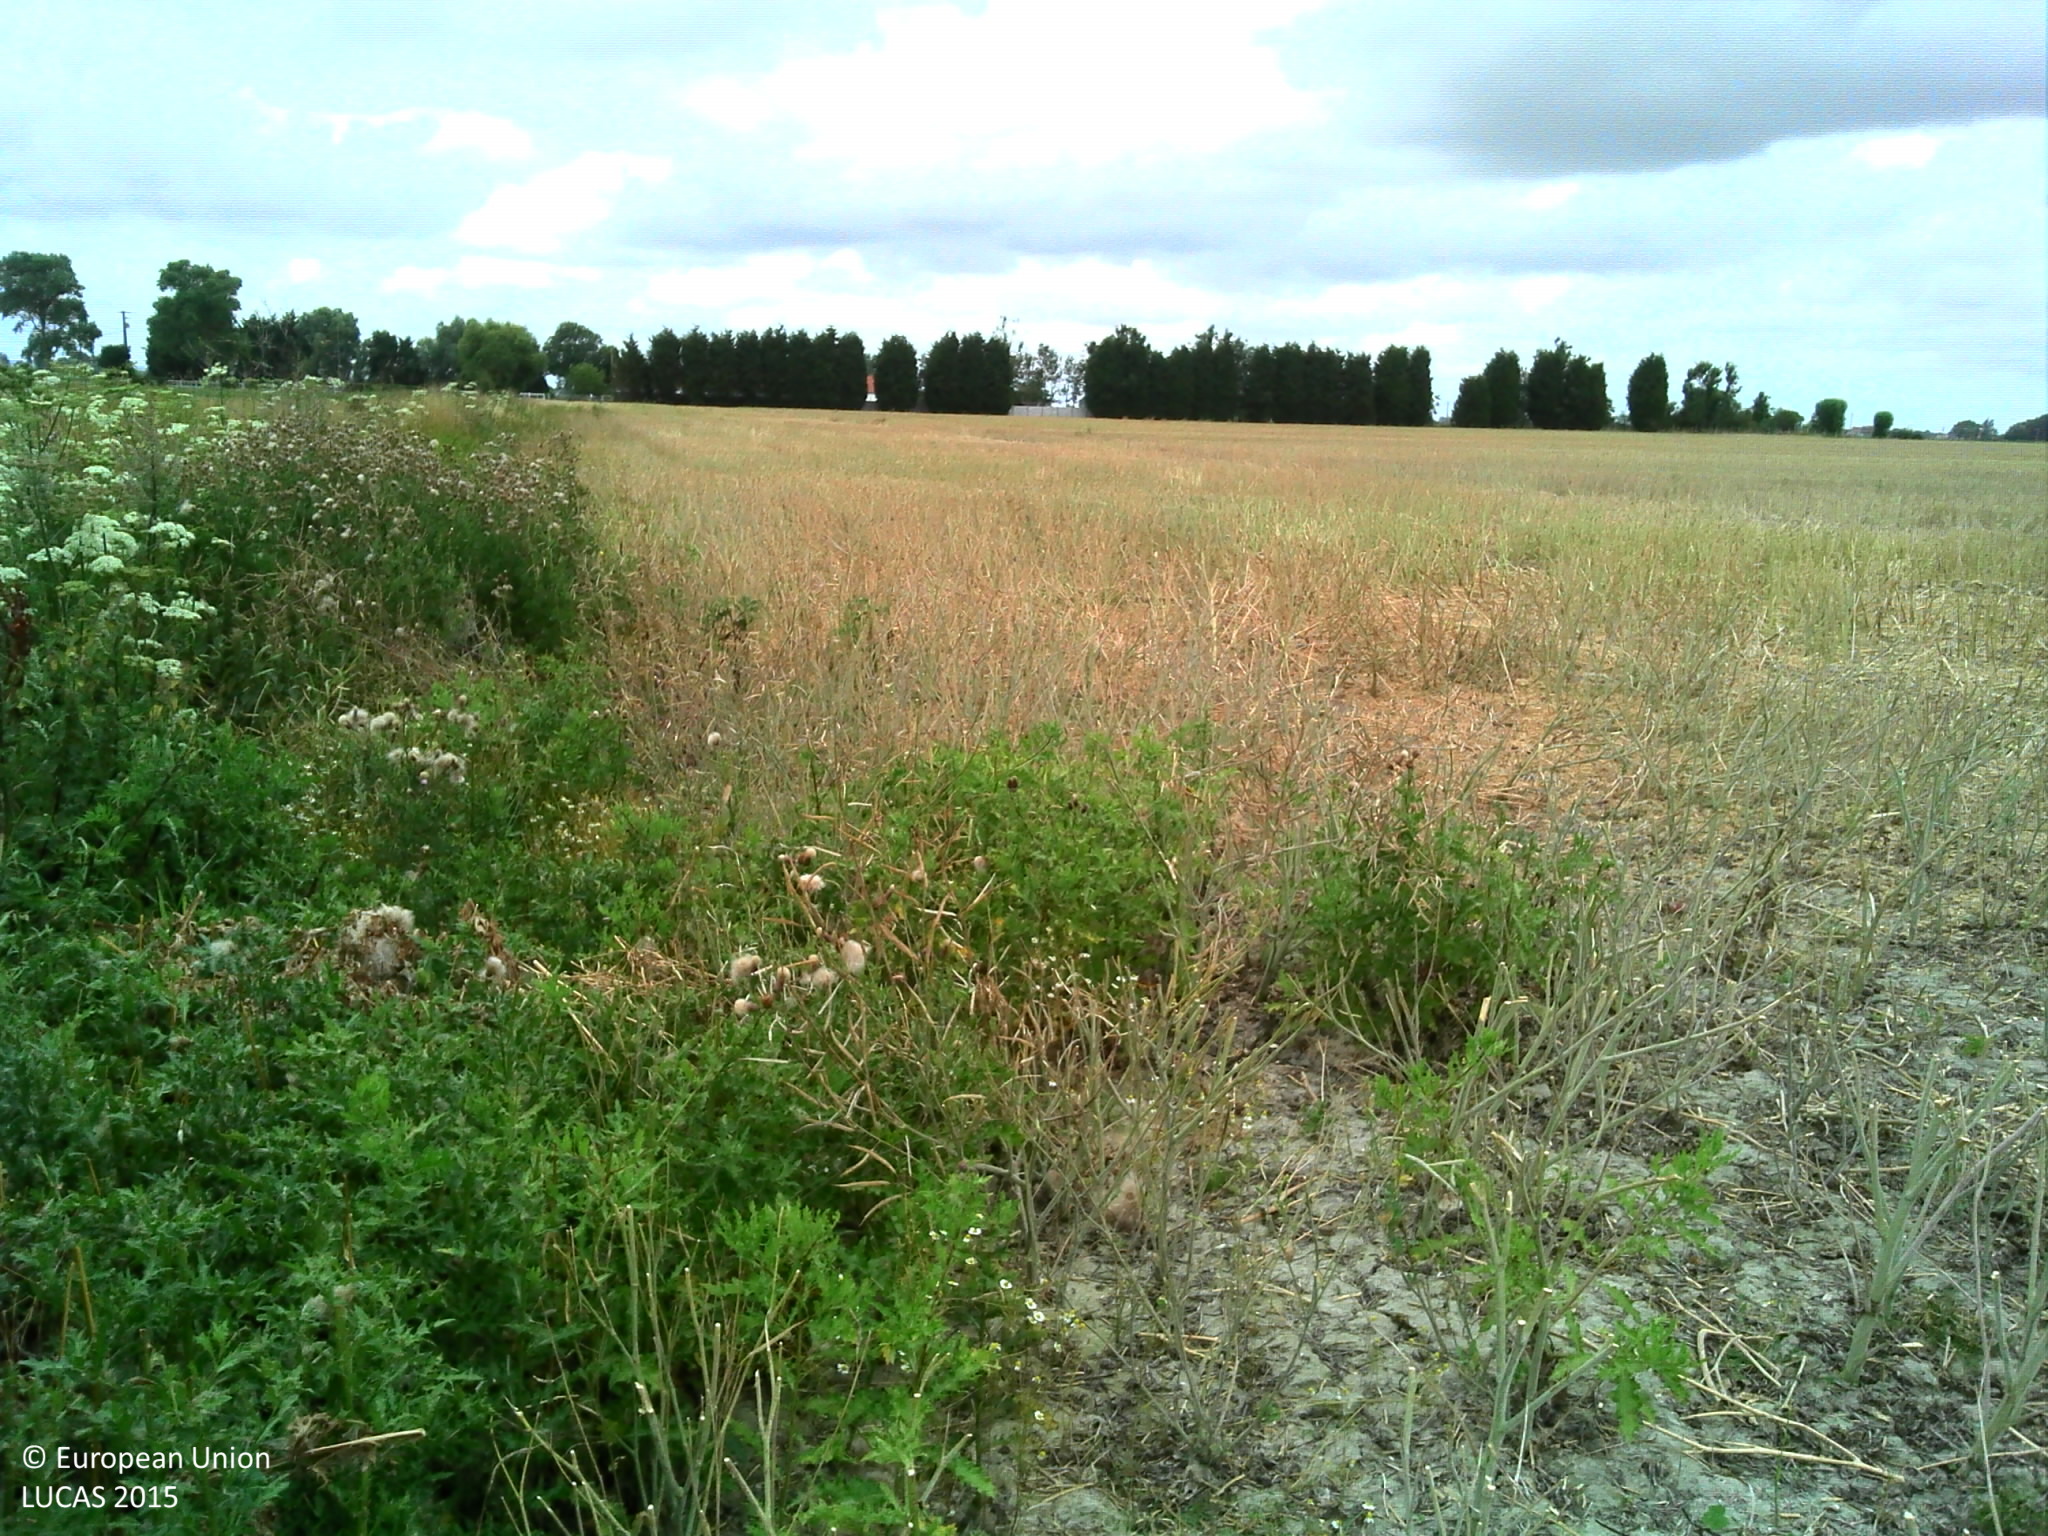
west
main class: Cropland
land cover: Rape and turnip rape
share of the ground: 10 - 25 %
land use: Agriculture (excluding fallow land and kitchen gardens)
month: August
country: FR
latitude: 50.9031
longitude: 2.0926
